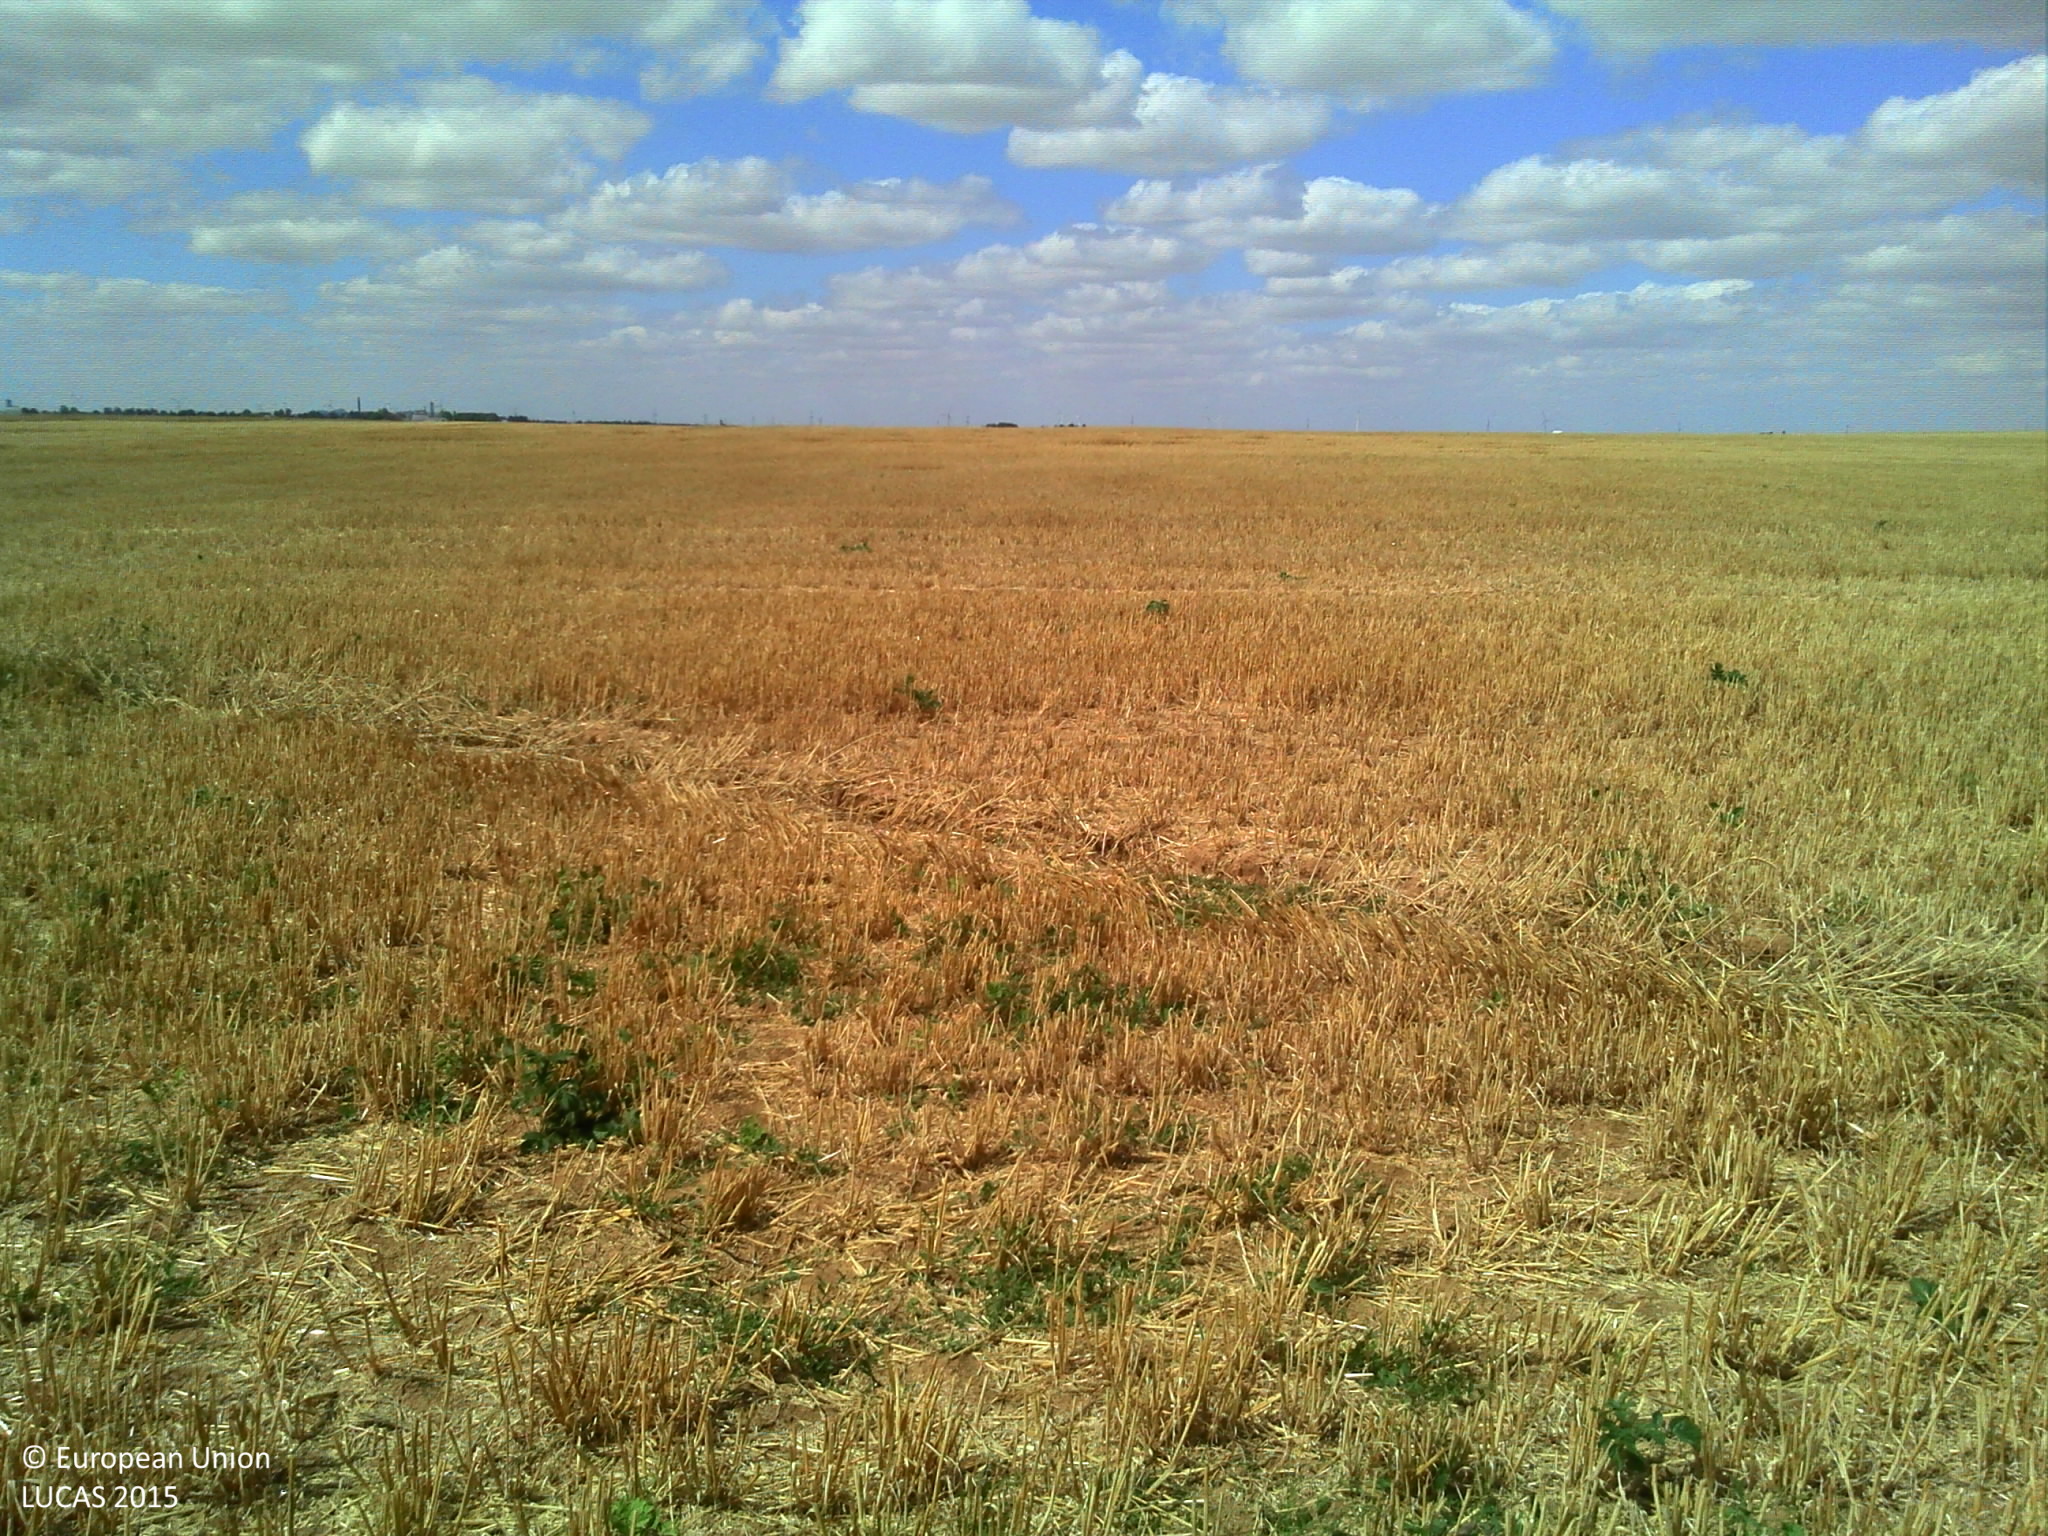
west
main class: Cropland
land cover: Common wheat
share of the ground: > 75 %
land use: Agriculture (excluding fallow land and kitchen gardens)
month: August
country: FR
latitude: 48.2043
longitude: 2.0080
